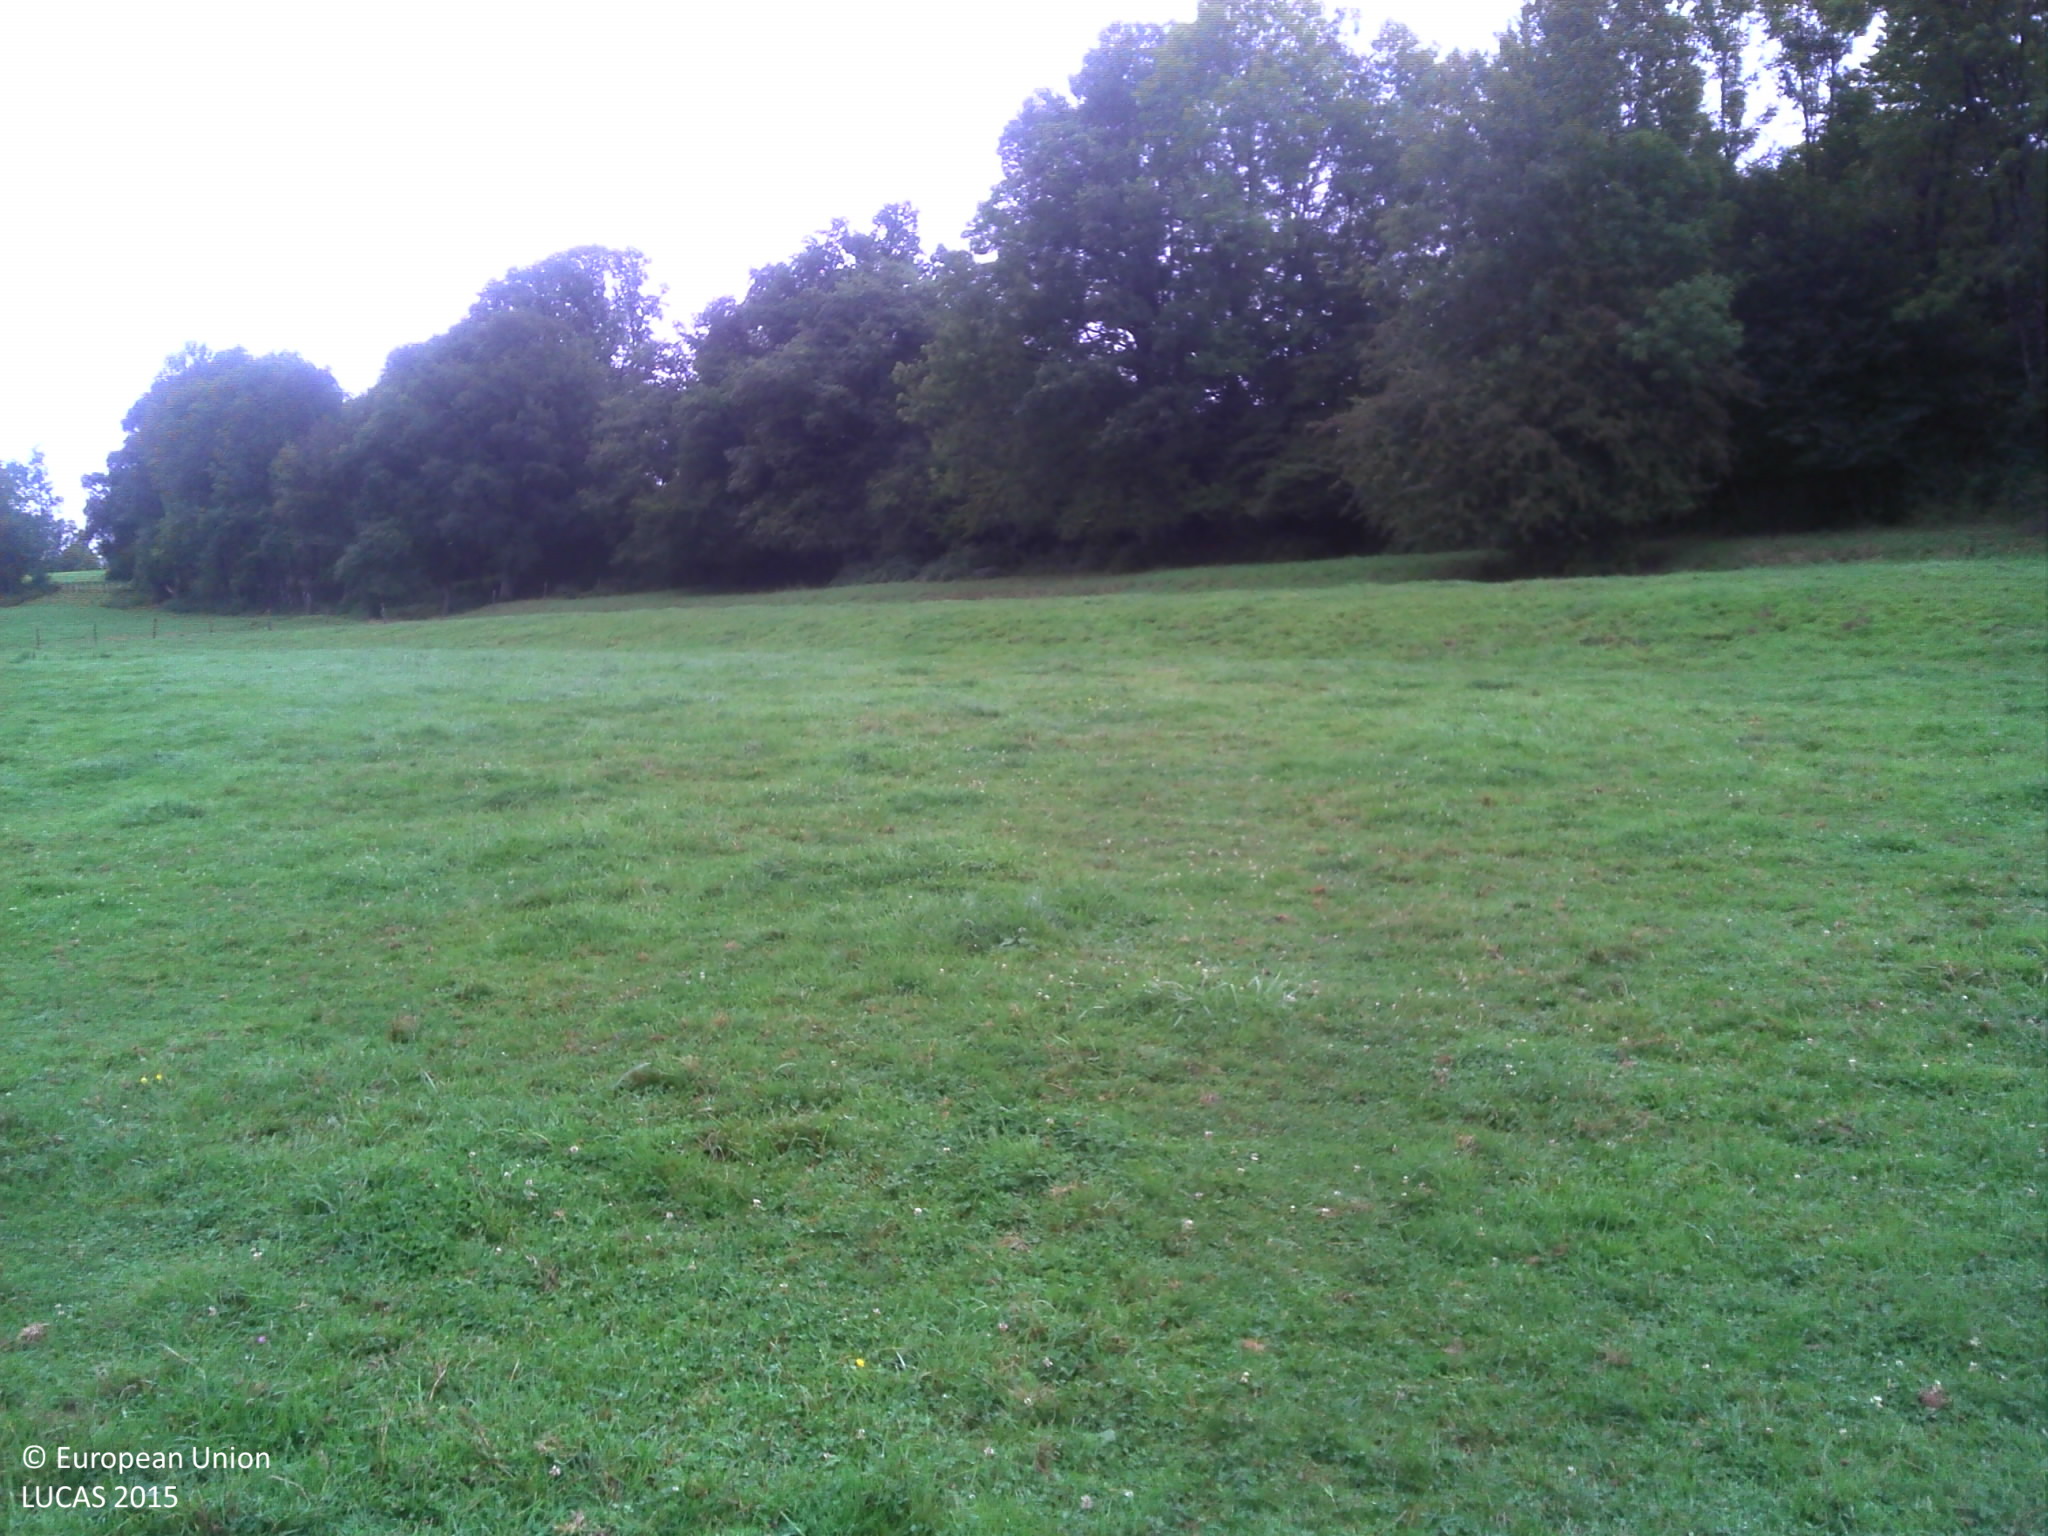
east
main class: Grassland
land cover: Grassland without tree/shrub cover
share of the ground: > 75 %
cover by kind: herbaceous plants 90 %, consolidated bare surface 10 %
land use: Agriculture (excluding fallow land and kitchen gardens)
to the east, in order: Grassland without tree/shrub cover; Broadleaved woodland; Fences; Broadleaved woodland; Grassland without tree/shrub cover; Broadleaved woodland; Grassland without tree/shrub cover
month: September
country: FR
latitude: 47.1648
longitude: 6.1368
